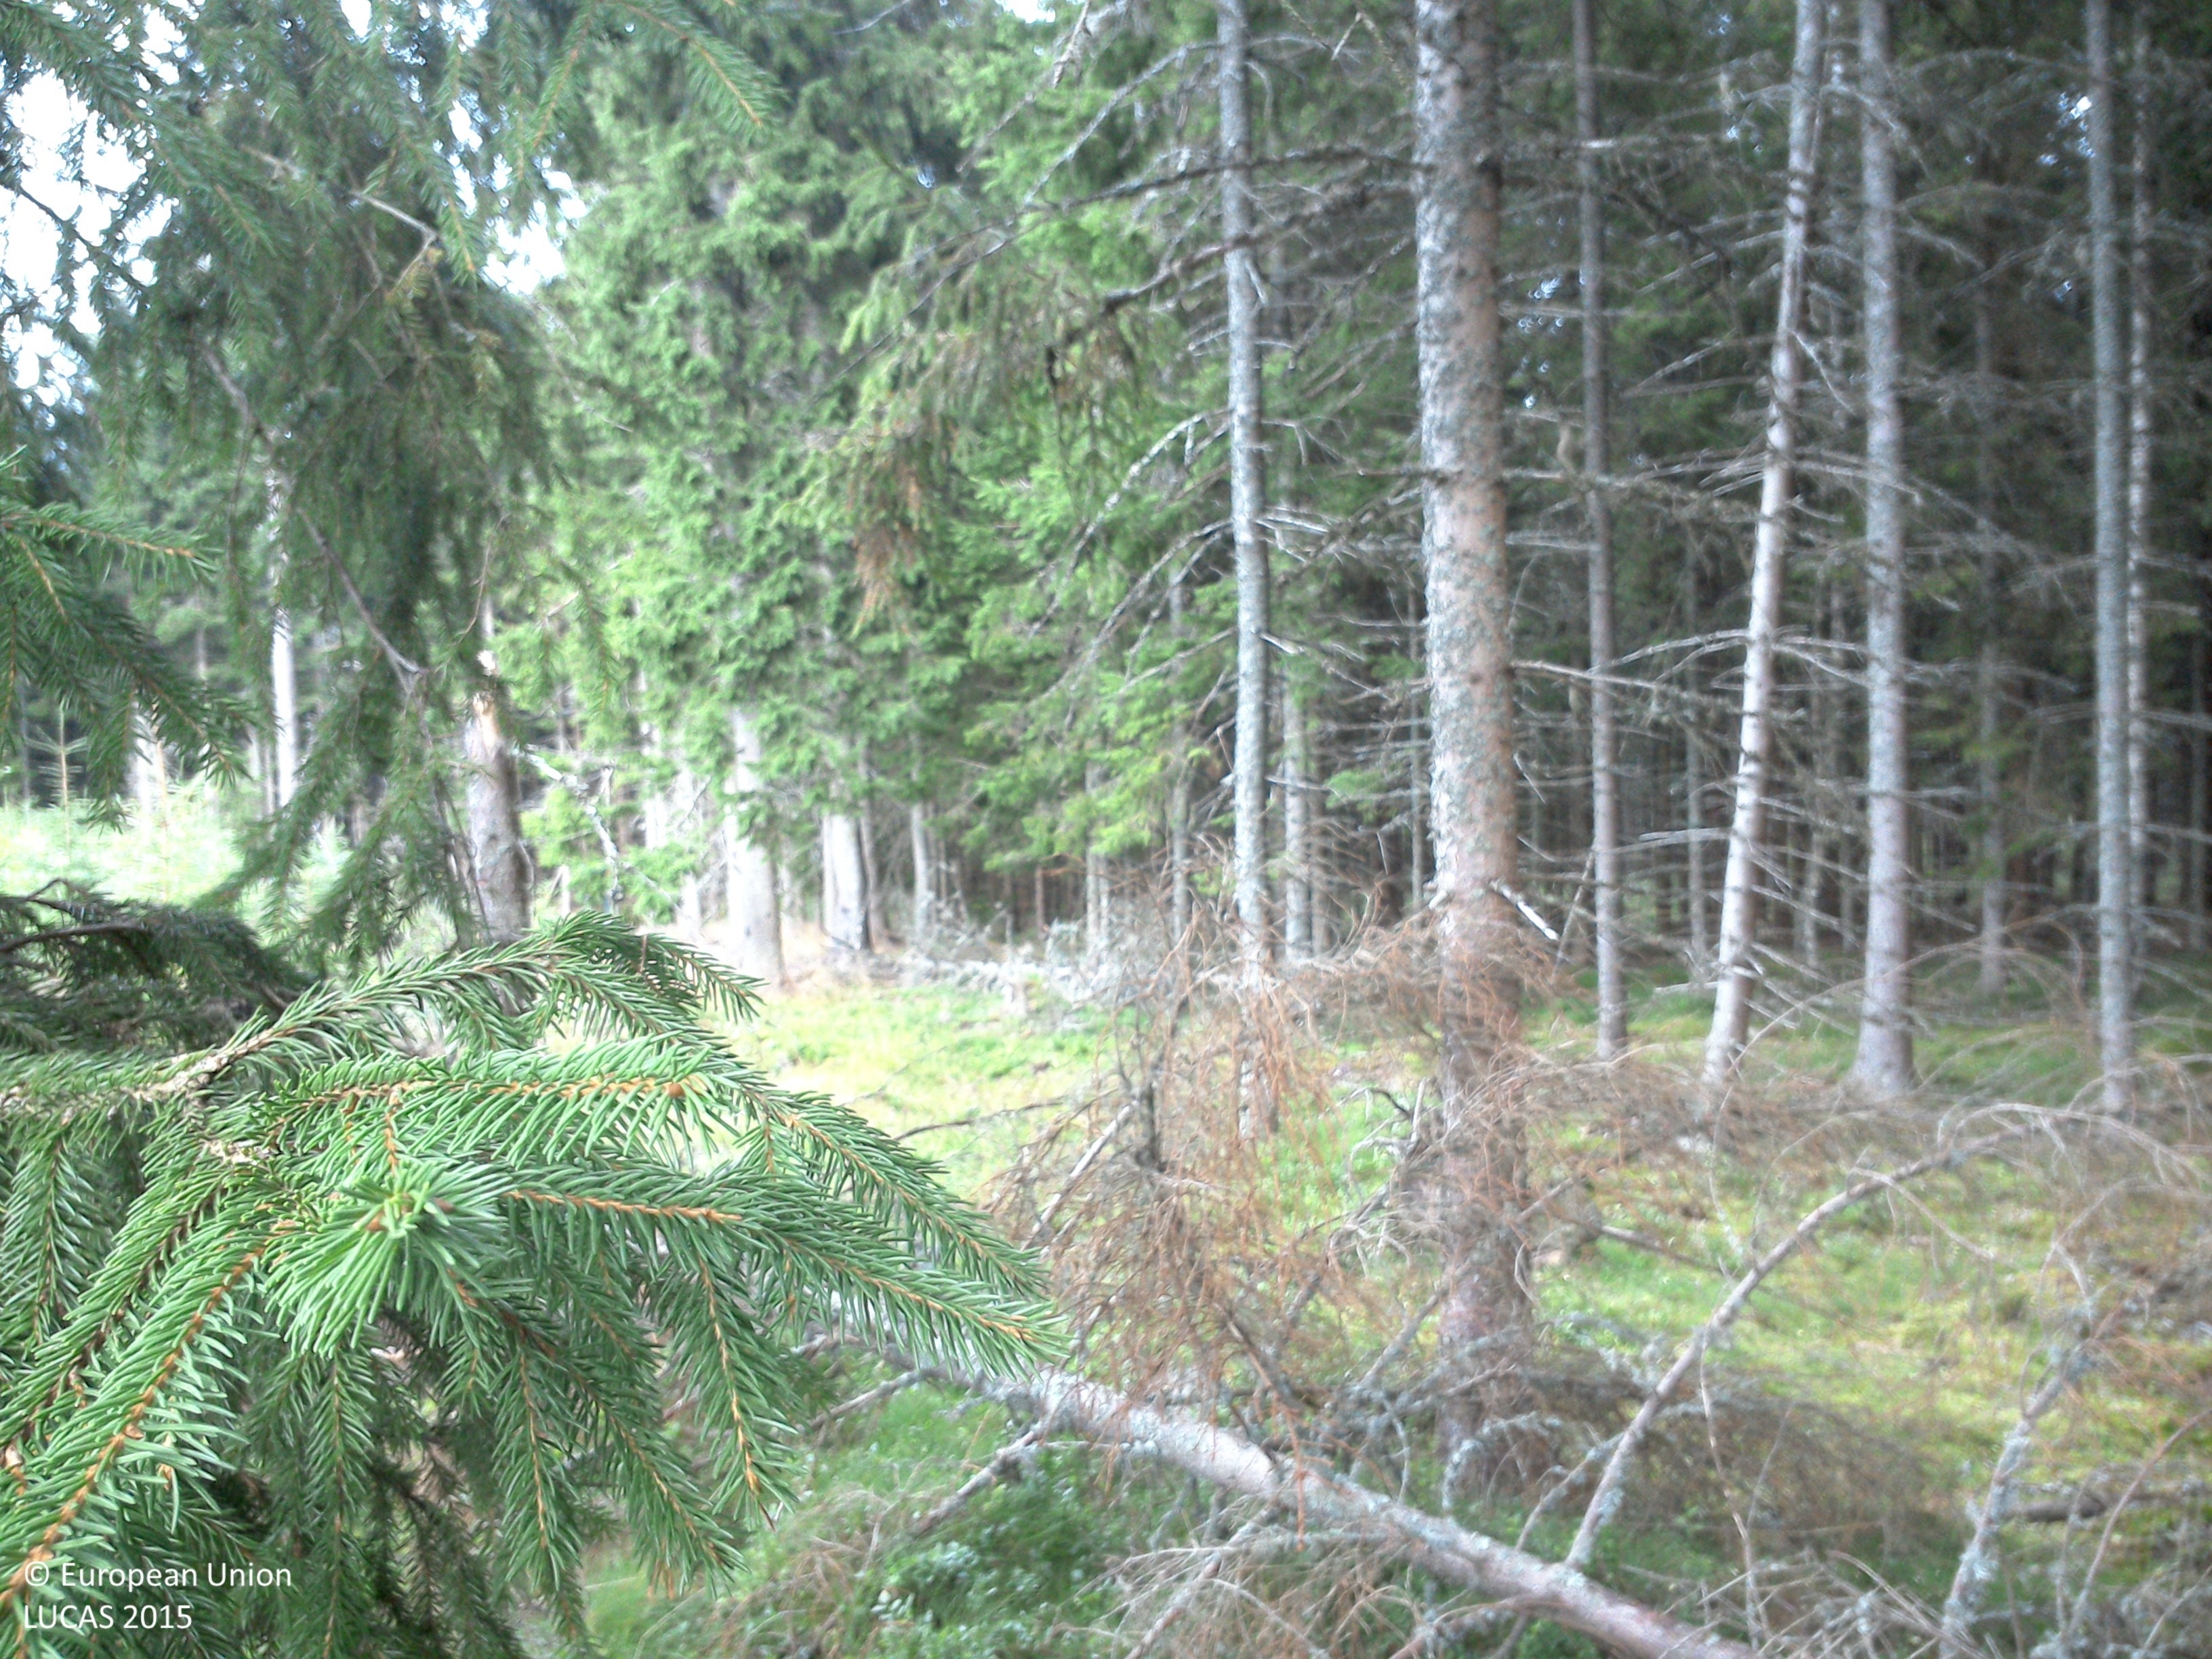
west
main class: Woodland
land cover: Spruce dominated coniferous woodland
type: boreal forest
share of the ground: > 75 %
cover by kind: coniferous forest trees 90 %, lichens and mosses 5 %, unconsolidated bare surface 5 %
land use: Forestry
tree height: > 5 m
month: August
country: SE
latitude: 57.7755
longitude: 15.2249
